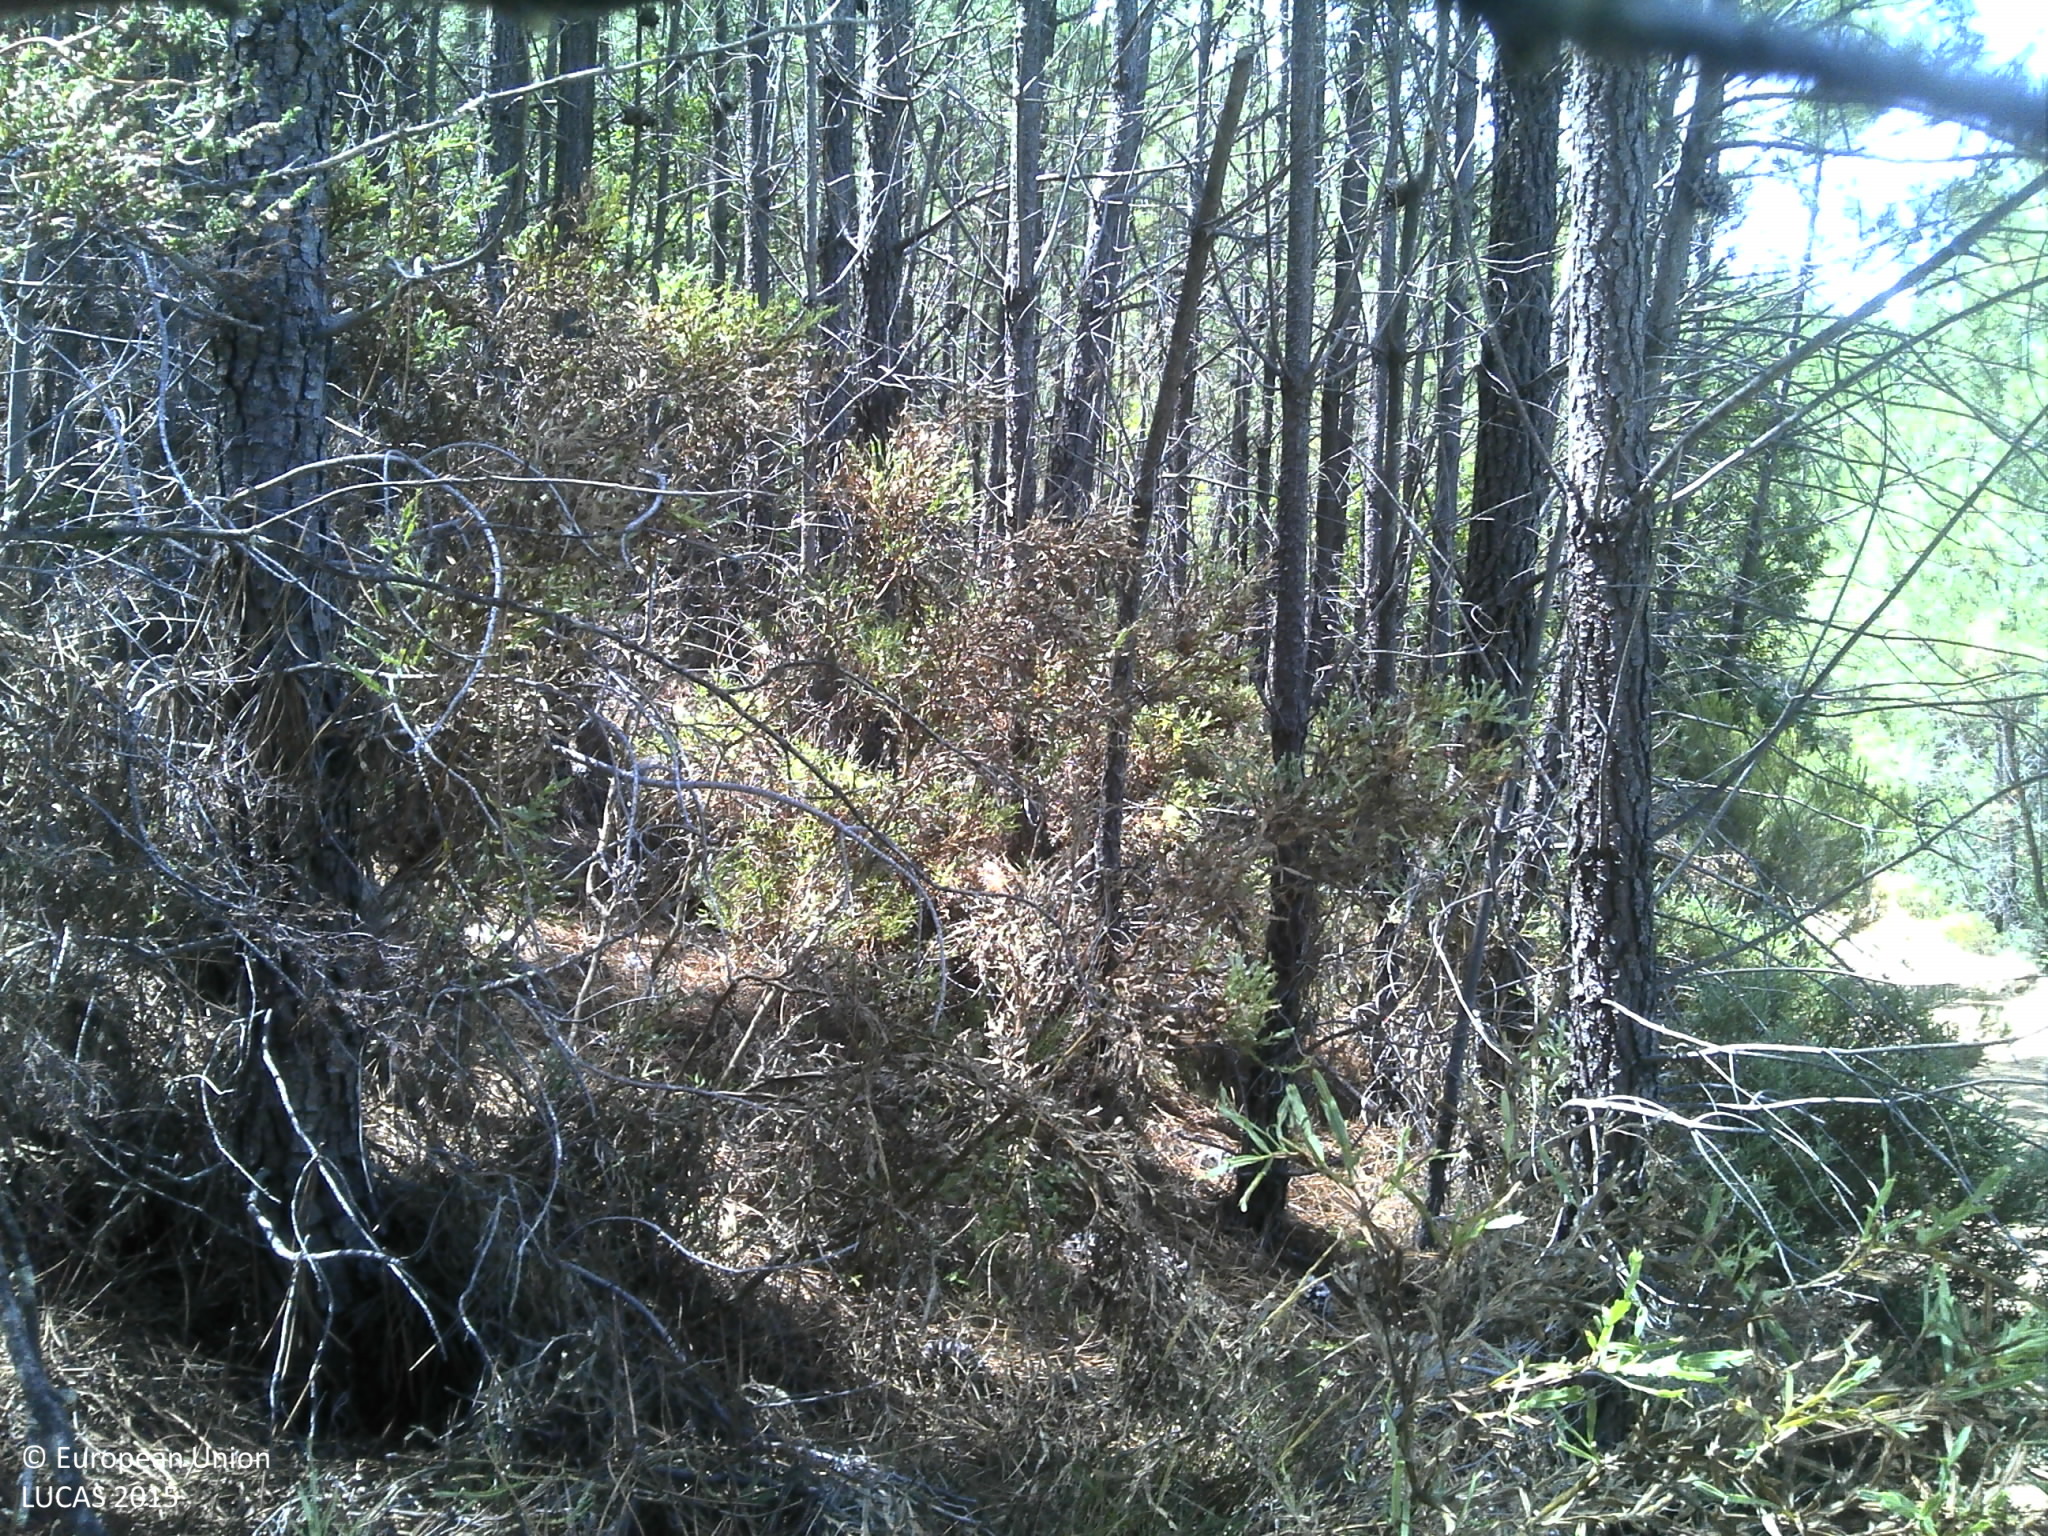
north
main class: Woodland
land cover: Pine dominated coniferous woodland
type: coniferous forest of the mediterranean region
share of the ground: 50 - 75 %
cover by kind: coniferous forest trees 75 %, shrubs 20 %
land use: Forestry
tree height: > 5 m
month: July
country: PT
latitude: 39.9287
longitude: -7.7407
